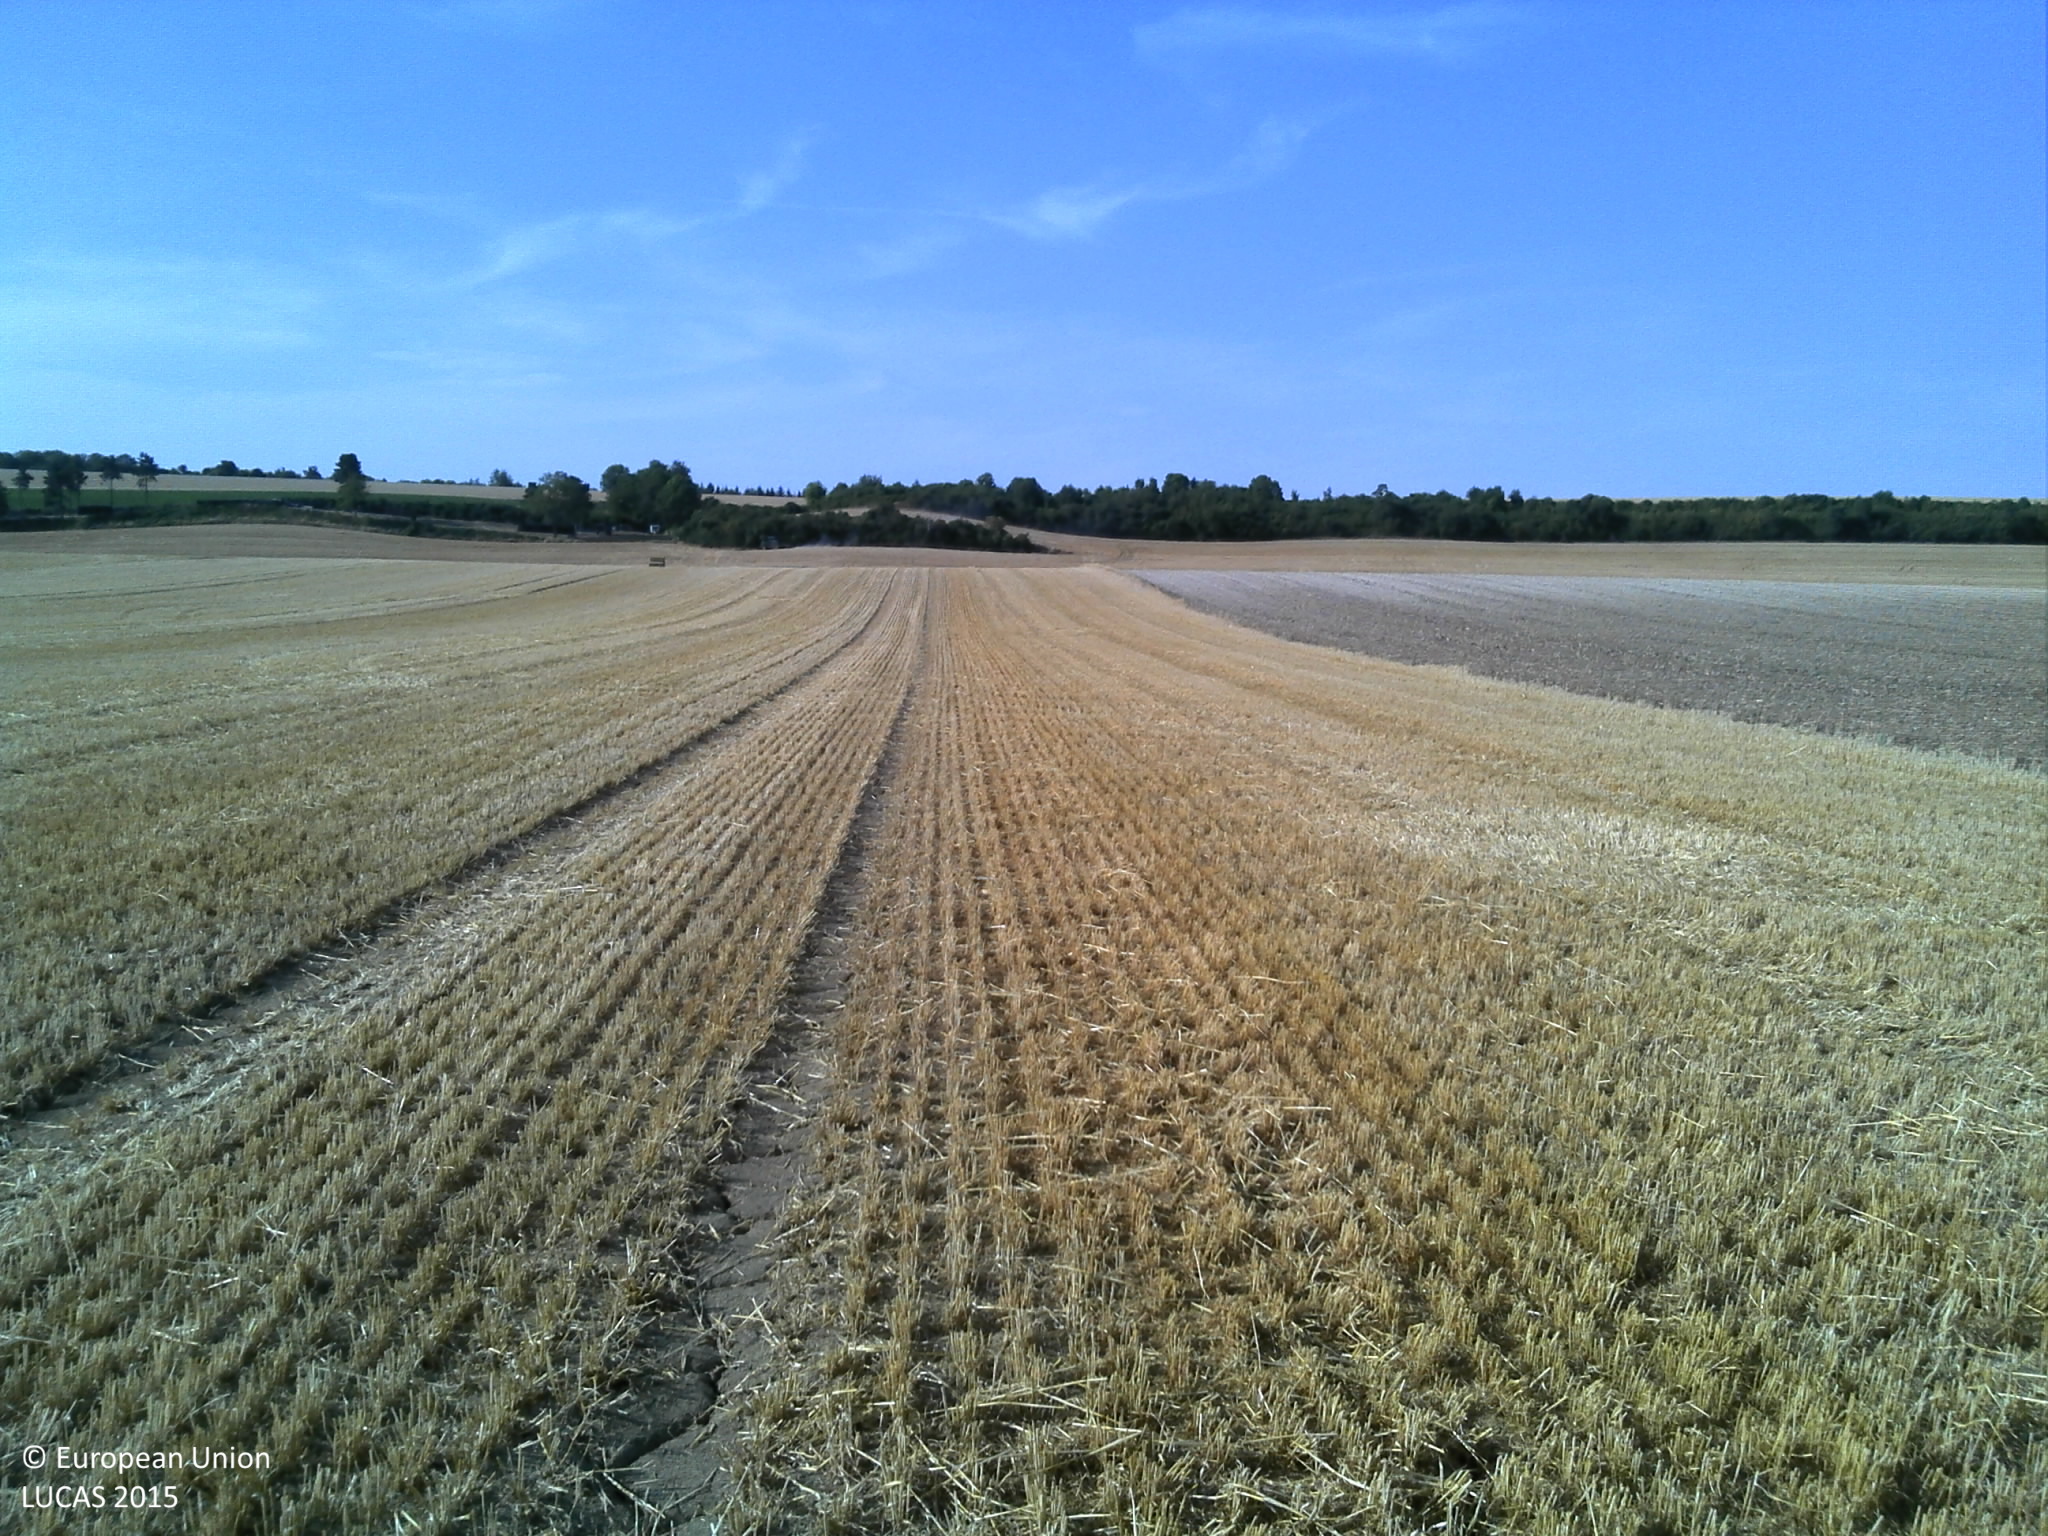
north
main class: Cropland
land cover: Barley
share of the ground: > 75 %
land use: Agriculture (excluding fallow land and kitchen gardens)
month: August
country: FR
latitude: 49.0736
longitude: 4.7818
